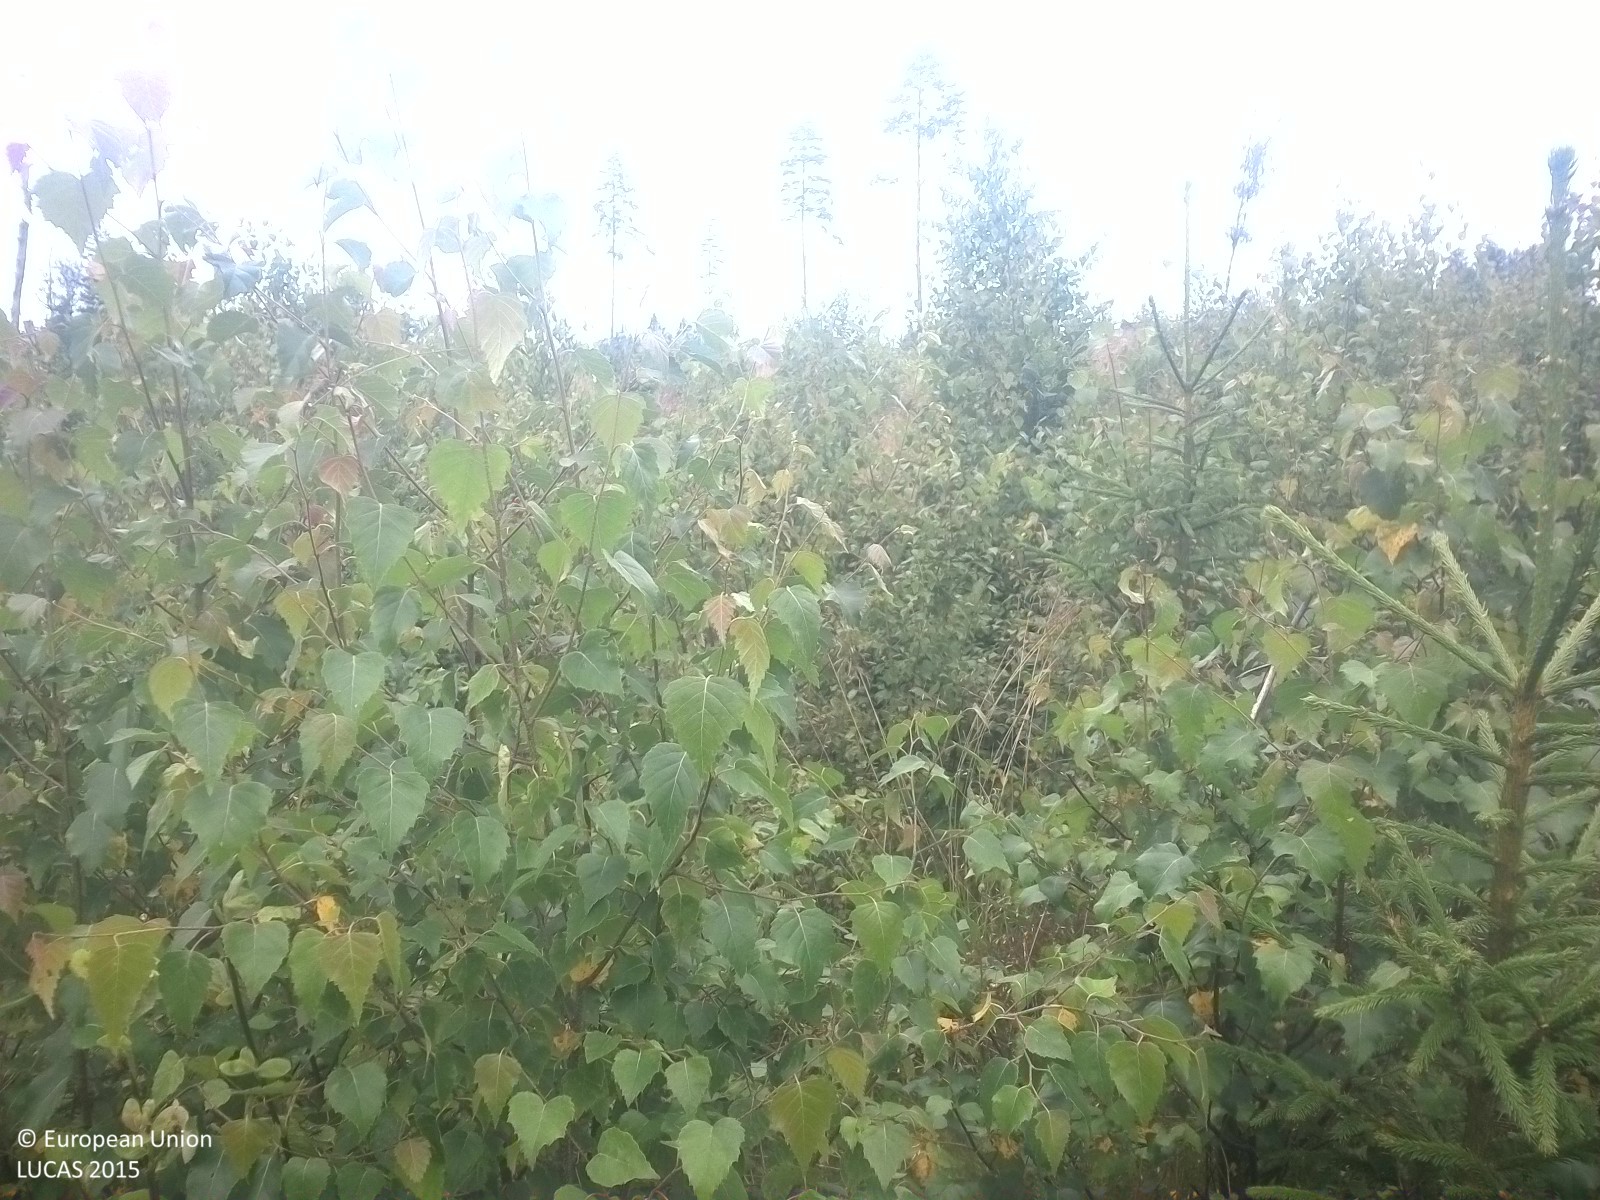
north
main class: Woodland
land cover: Spruce dominated mixed woodland
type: boreal forest
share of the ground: 50 - 75 %
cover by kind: coniferous forest trees 35 %, broadleaved forest trees 30 %, herbaceous plants 25 %, shrubs 5 %, lichens and mosses 5 %
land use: Forestry
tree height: < 5 m
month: July
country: SE
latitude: 58.9219
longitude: 14.9424
